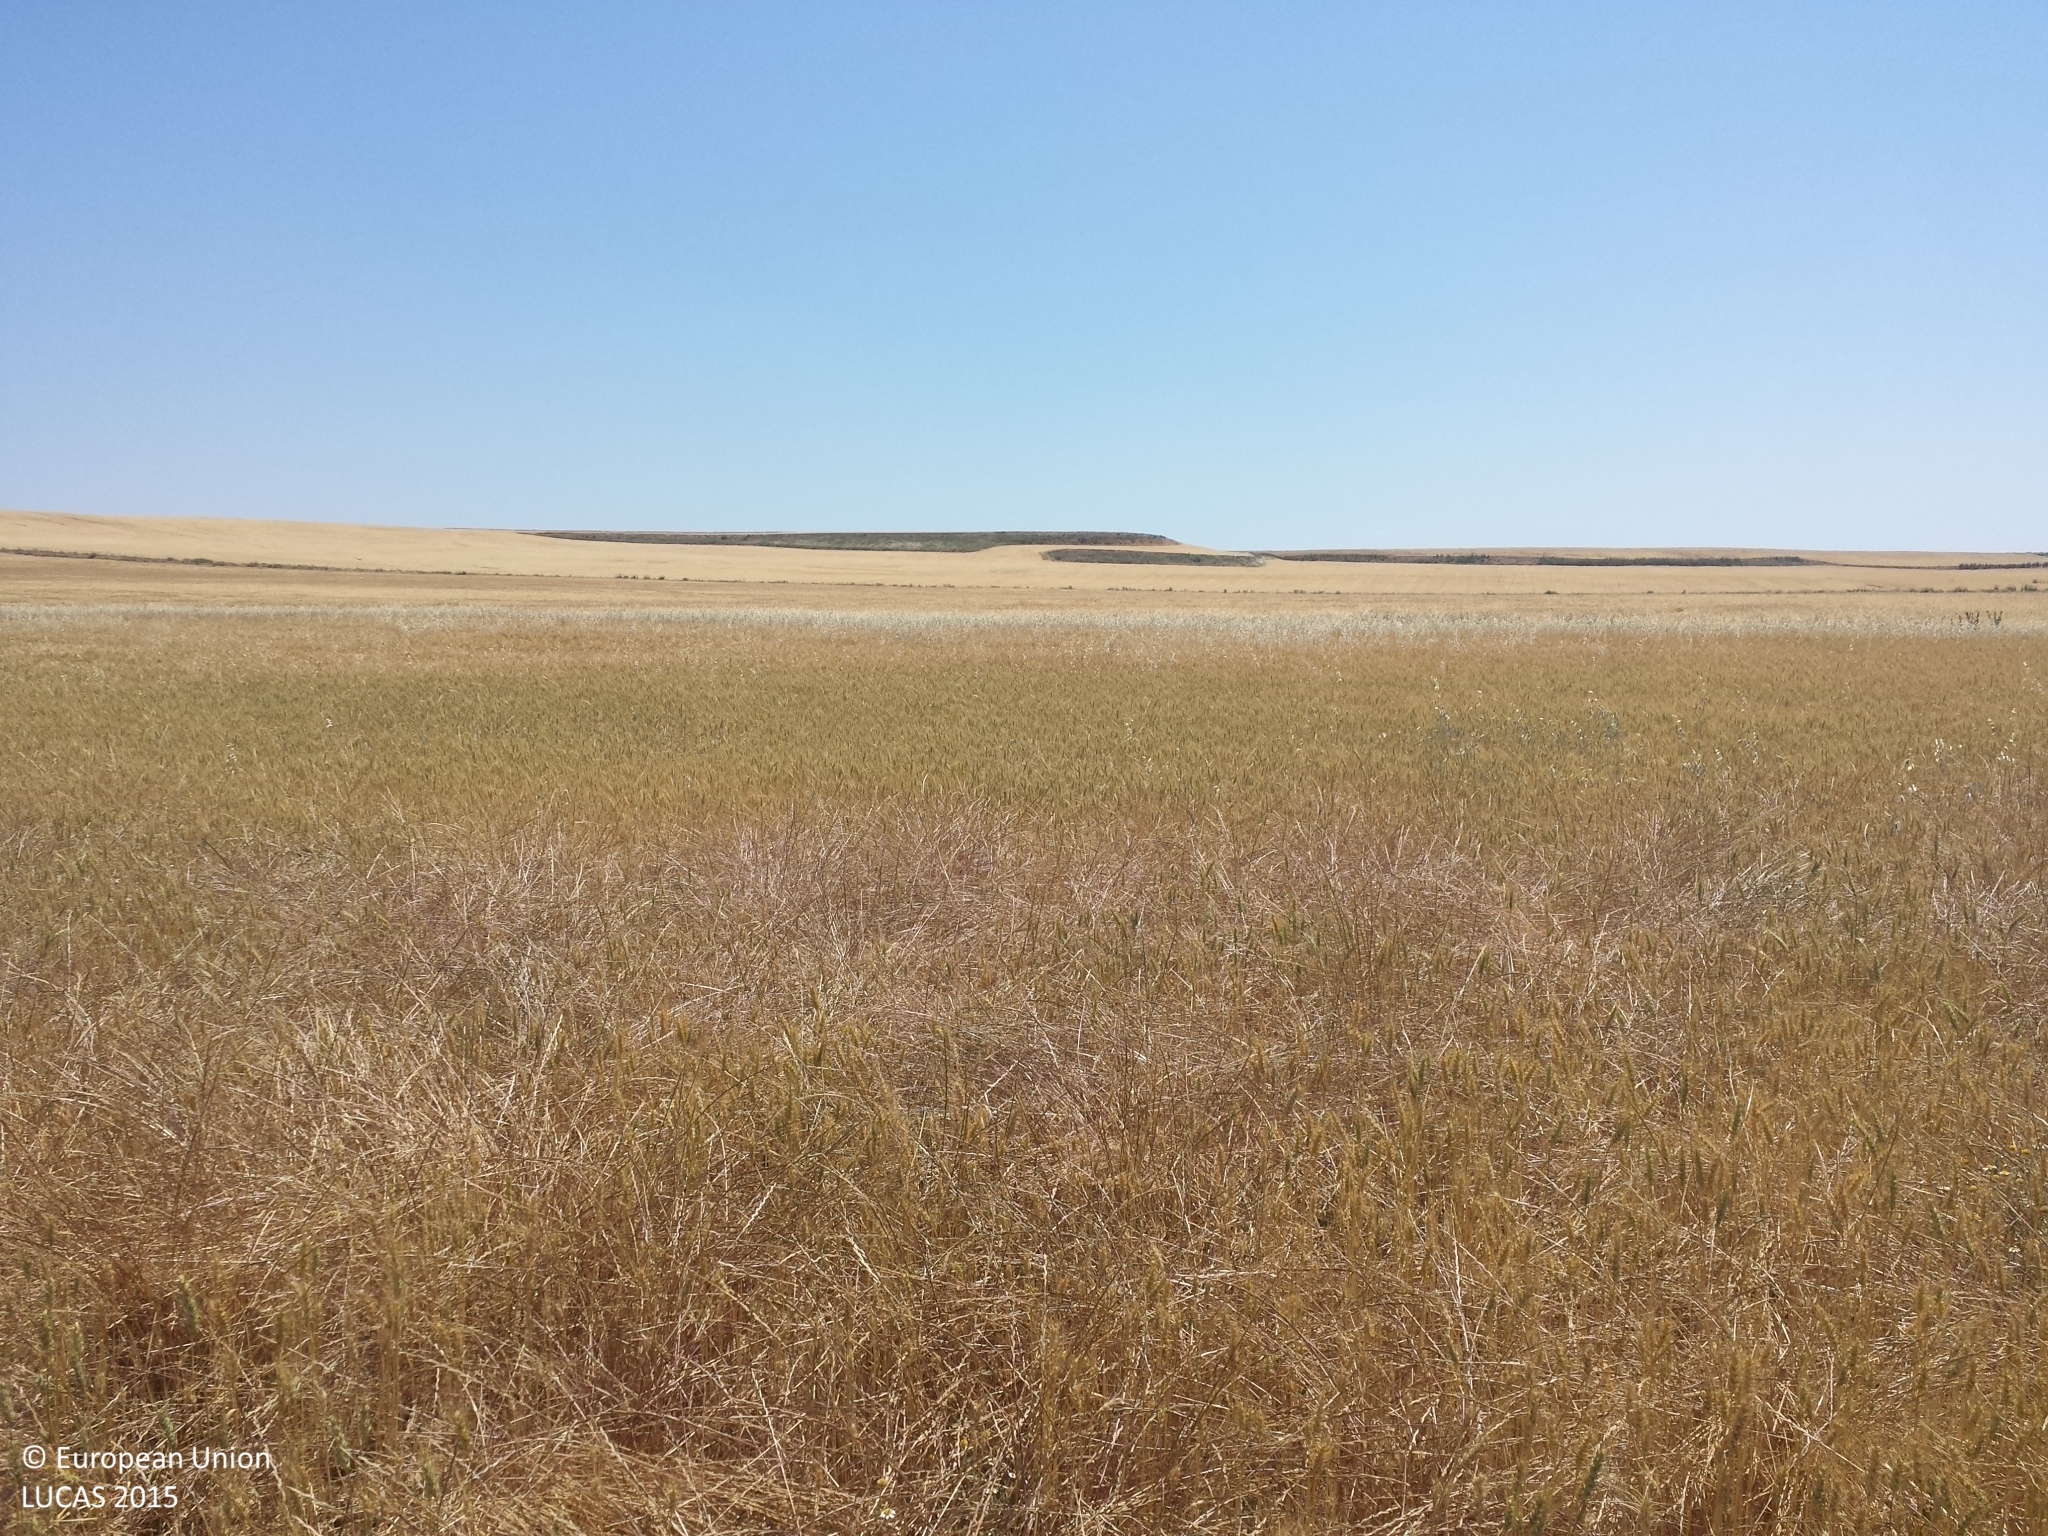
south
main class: Cropland
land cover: Common wheat
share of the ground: > 75 %
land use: Agriculture (excluding fallow land and kitchen gardens)
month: May
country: ES
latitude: 41.7564
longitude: 0.5450
